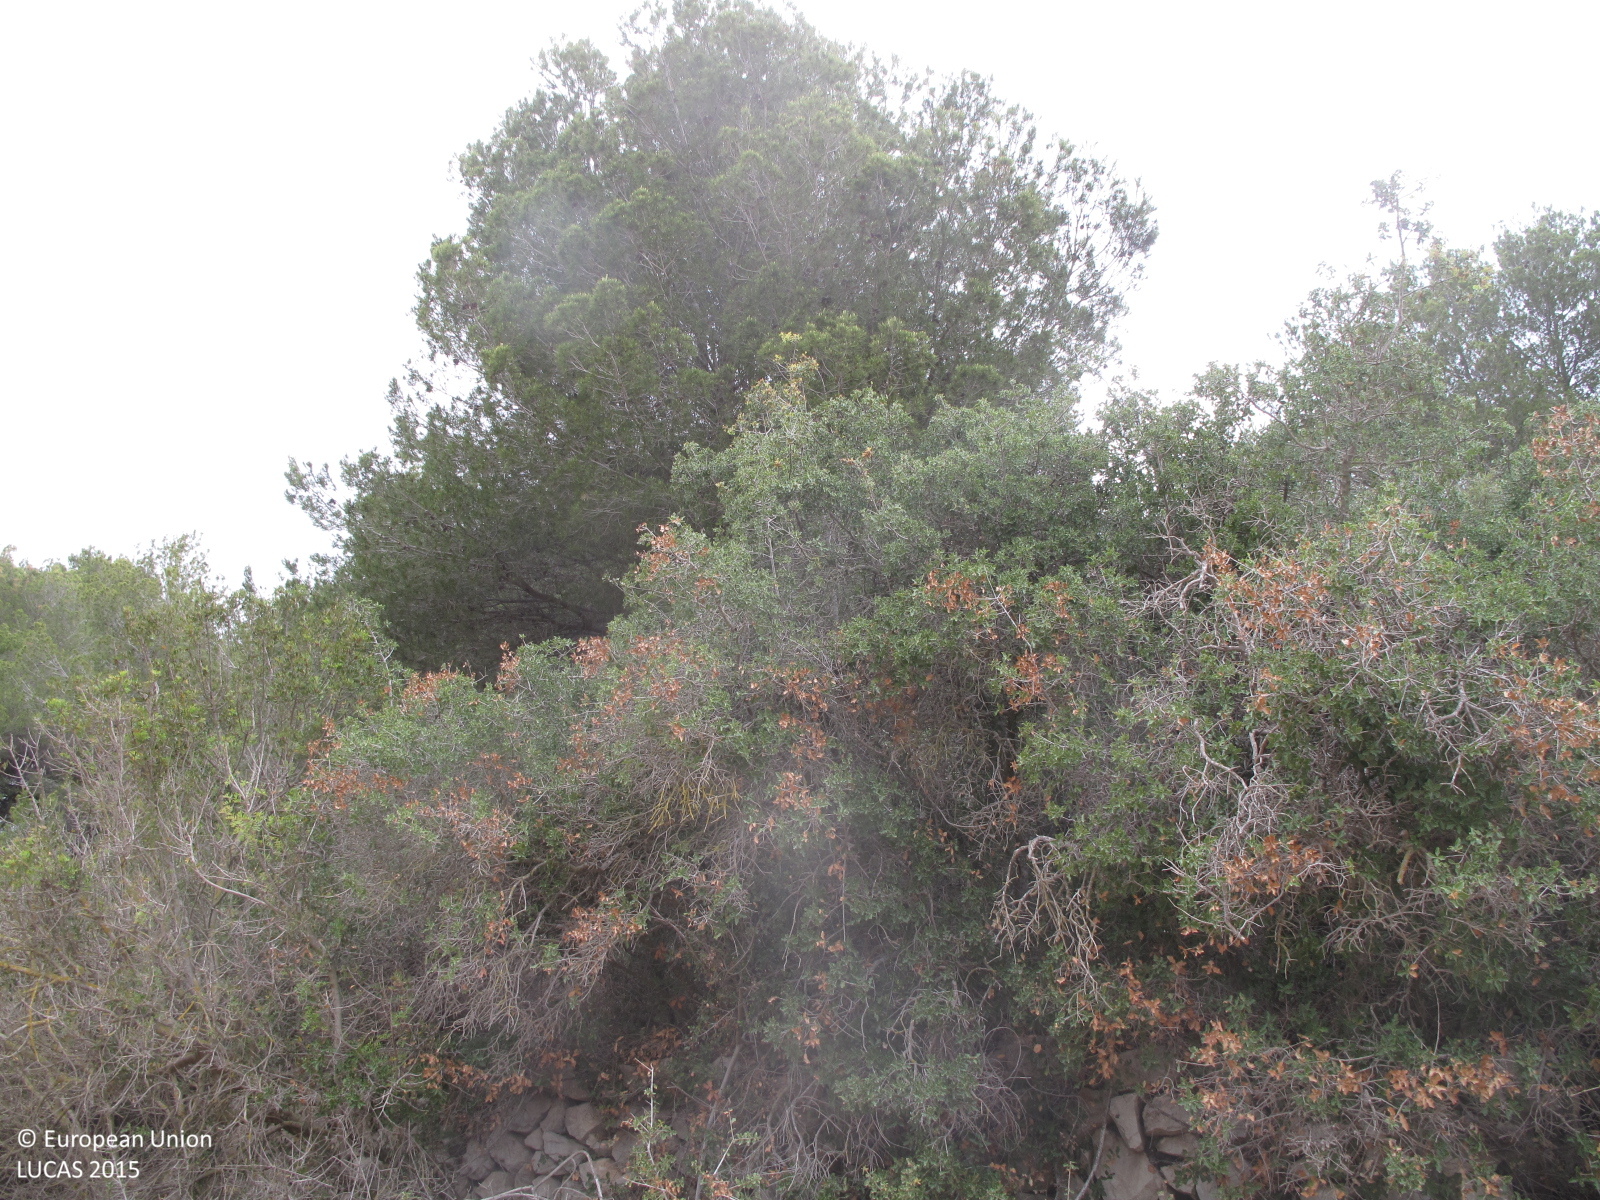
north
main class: Cropland
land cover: Vineyards
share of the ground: 10 - 25 %
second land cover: Other bare soil
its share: > 75 %
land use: Agriculture (excluding fallow land and kitchen gardens)
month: May
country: ES
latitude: 38.6913
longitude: 0.1139
